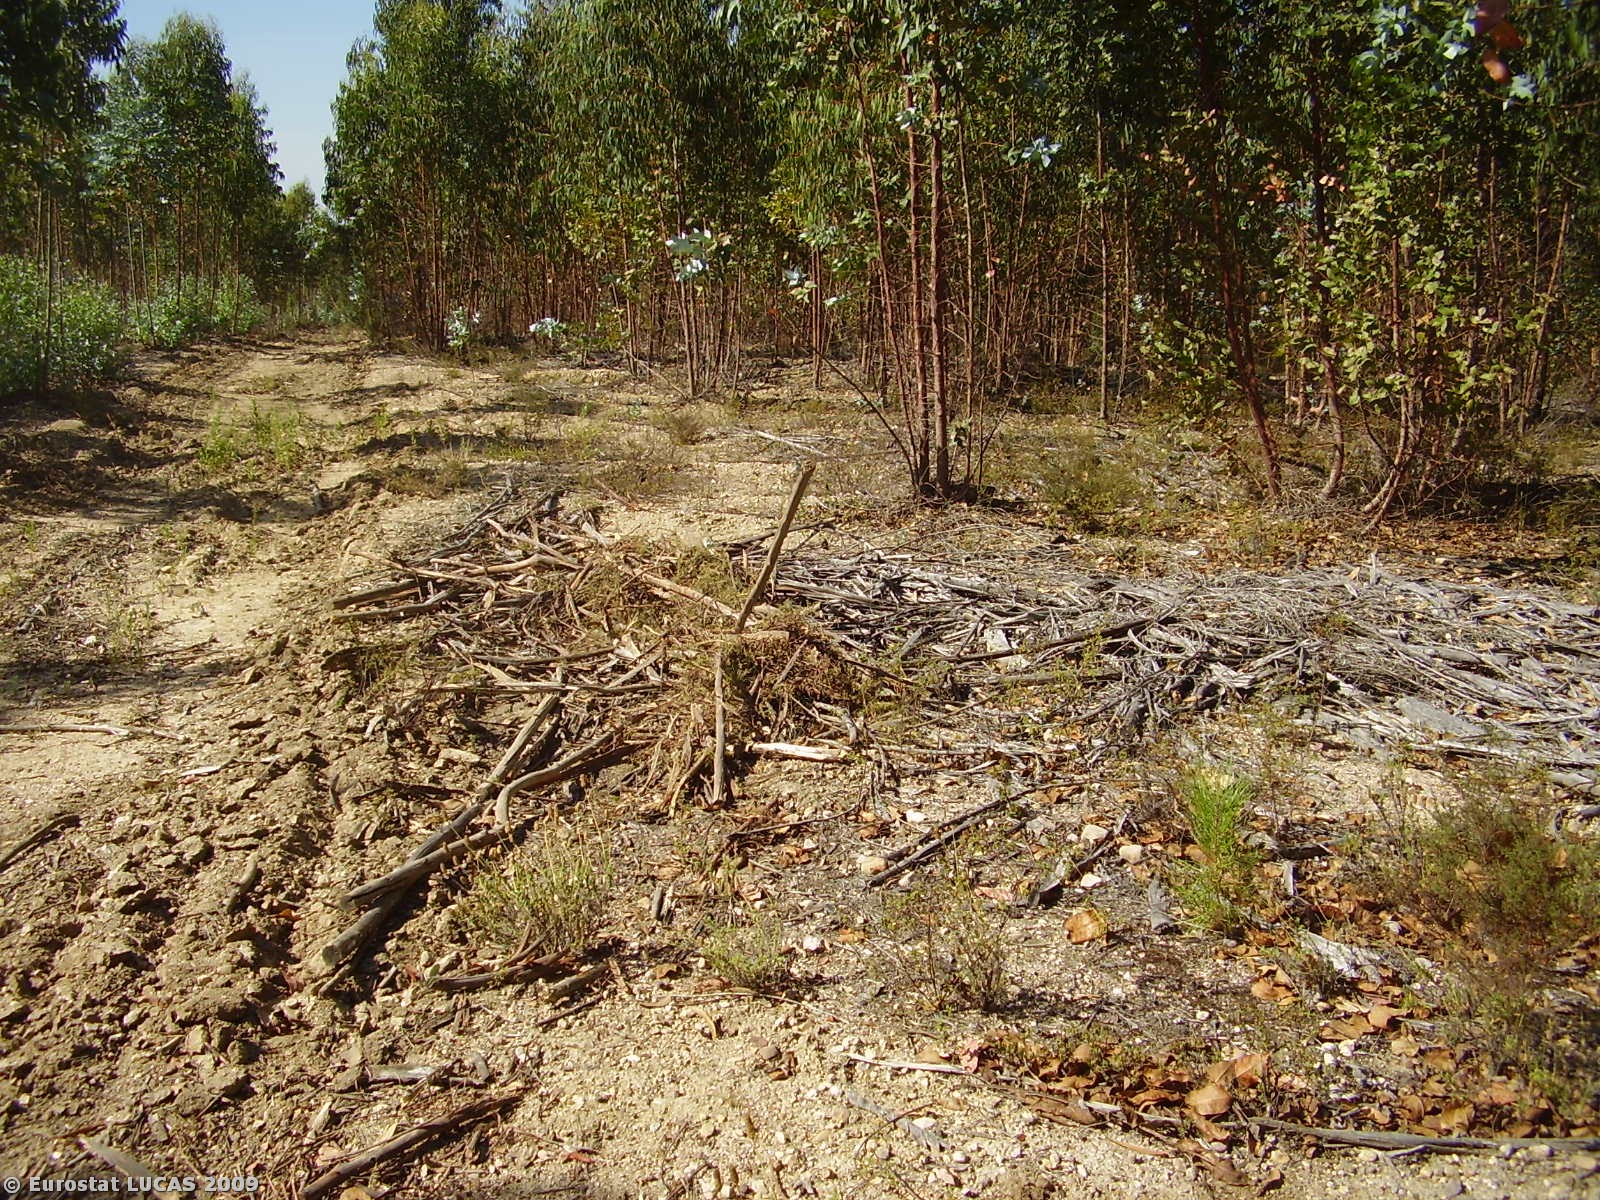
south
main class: Woodland
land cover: Broadleaved woodland
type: plantations and self-sown exotic forest
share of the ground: 25 - 50 %
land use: Forestry
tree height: > 5 m
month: July
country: PT
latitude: 39.3404
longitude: -8.3152
